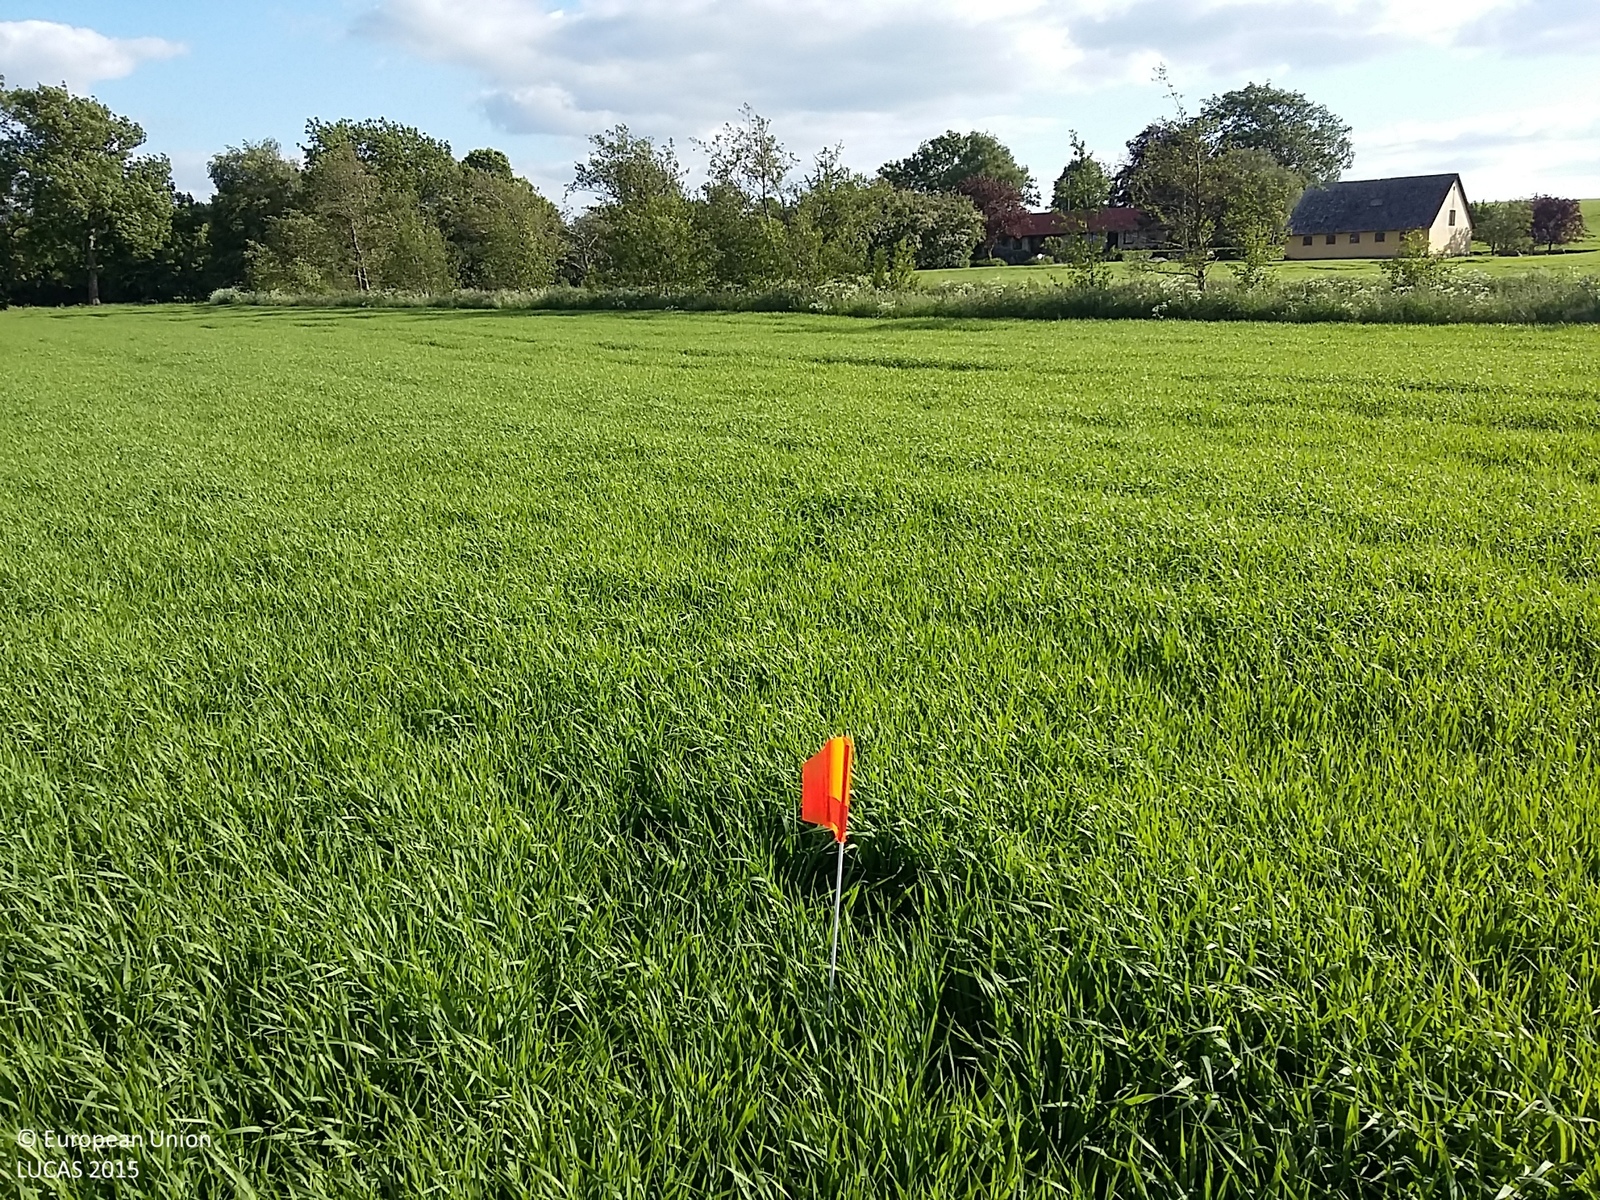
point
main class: Cropland
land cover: Barley
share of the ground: > 75 %
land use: Agriculture (excluding fallow land and kitchen gardens)
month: June
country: DK
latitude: 55.2153
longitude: 10.6753
